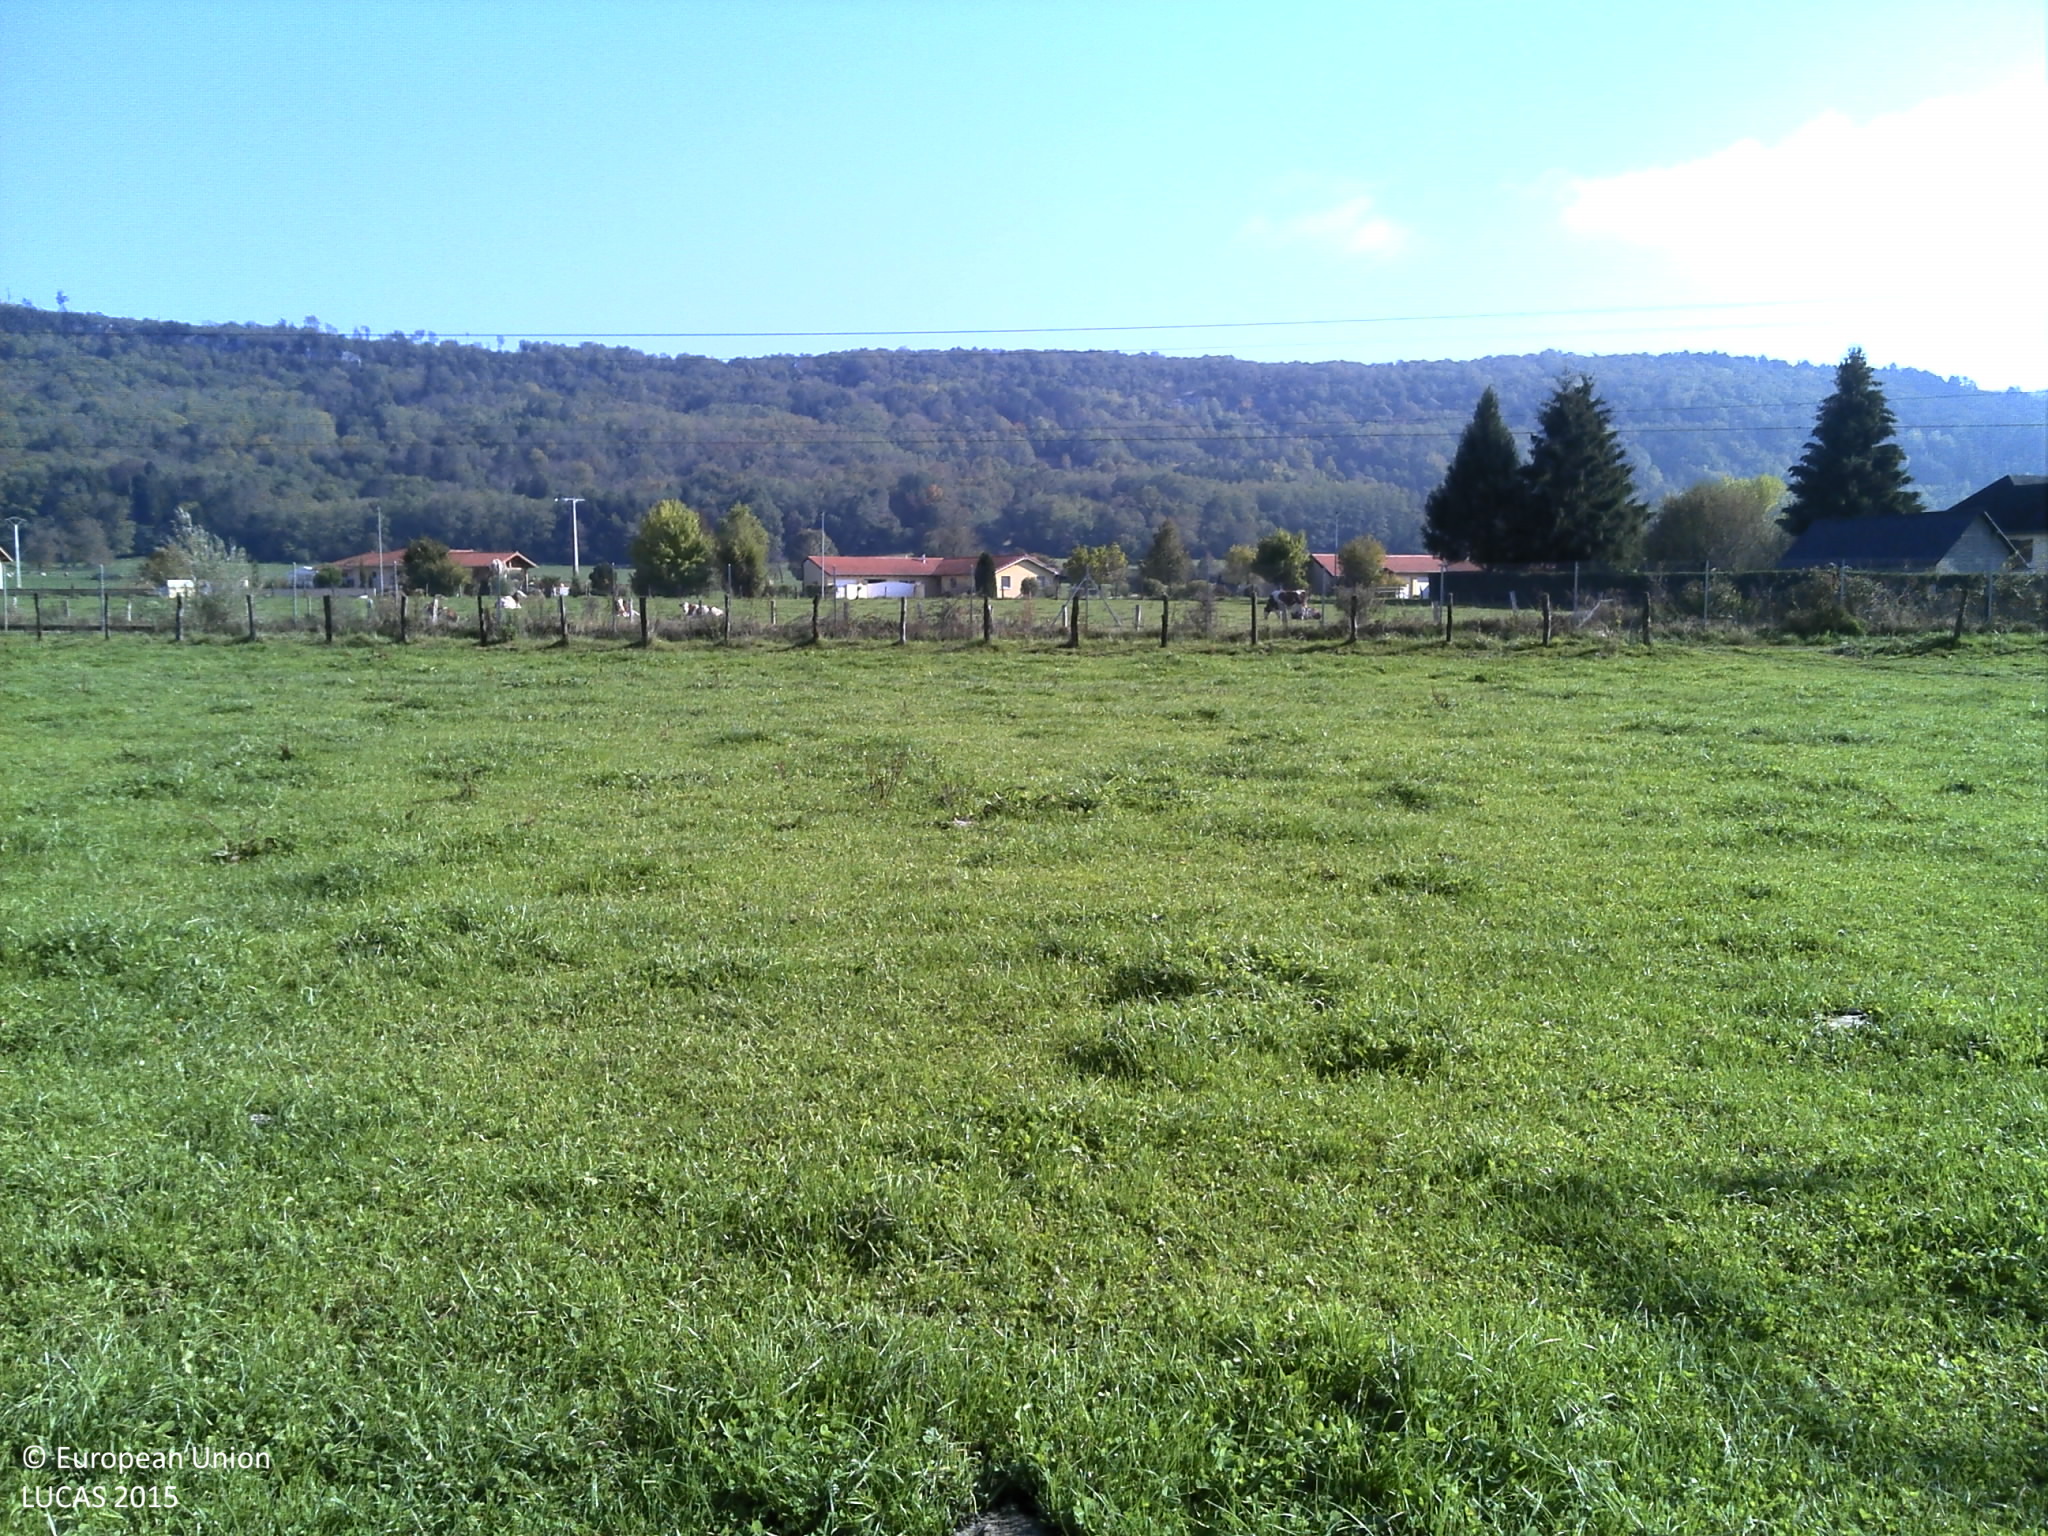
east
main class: Grassland
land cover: Grassland without tree/shrub cover
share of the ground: > 75 %
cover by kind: herbaceous plants 100 %
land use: Agriculture (excluding fallow land and kitchen gardens)
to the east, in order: Grassland without tree/shrub cover; Electric lines; Grassland without tree/shrub cover; Fences; Grass margins; Tracks; Grass margins; Fences; Electric lines; Railways; Electric lines; Shruby margins; Fences; Grassland without tree/shrub cover; Artificial constructions in urban areas; Grassland without tree/shrub cover
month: October
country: FR
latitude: 46.1983
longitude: 5.4028
